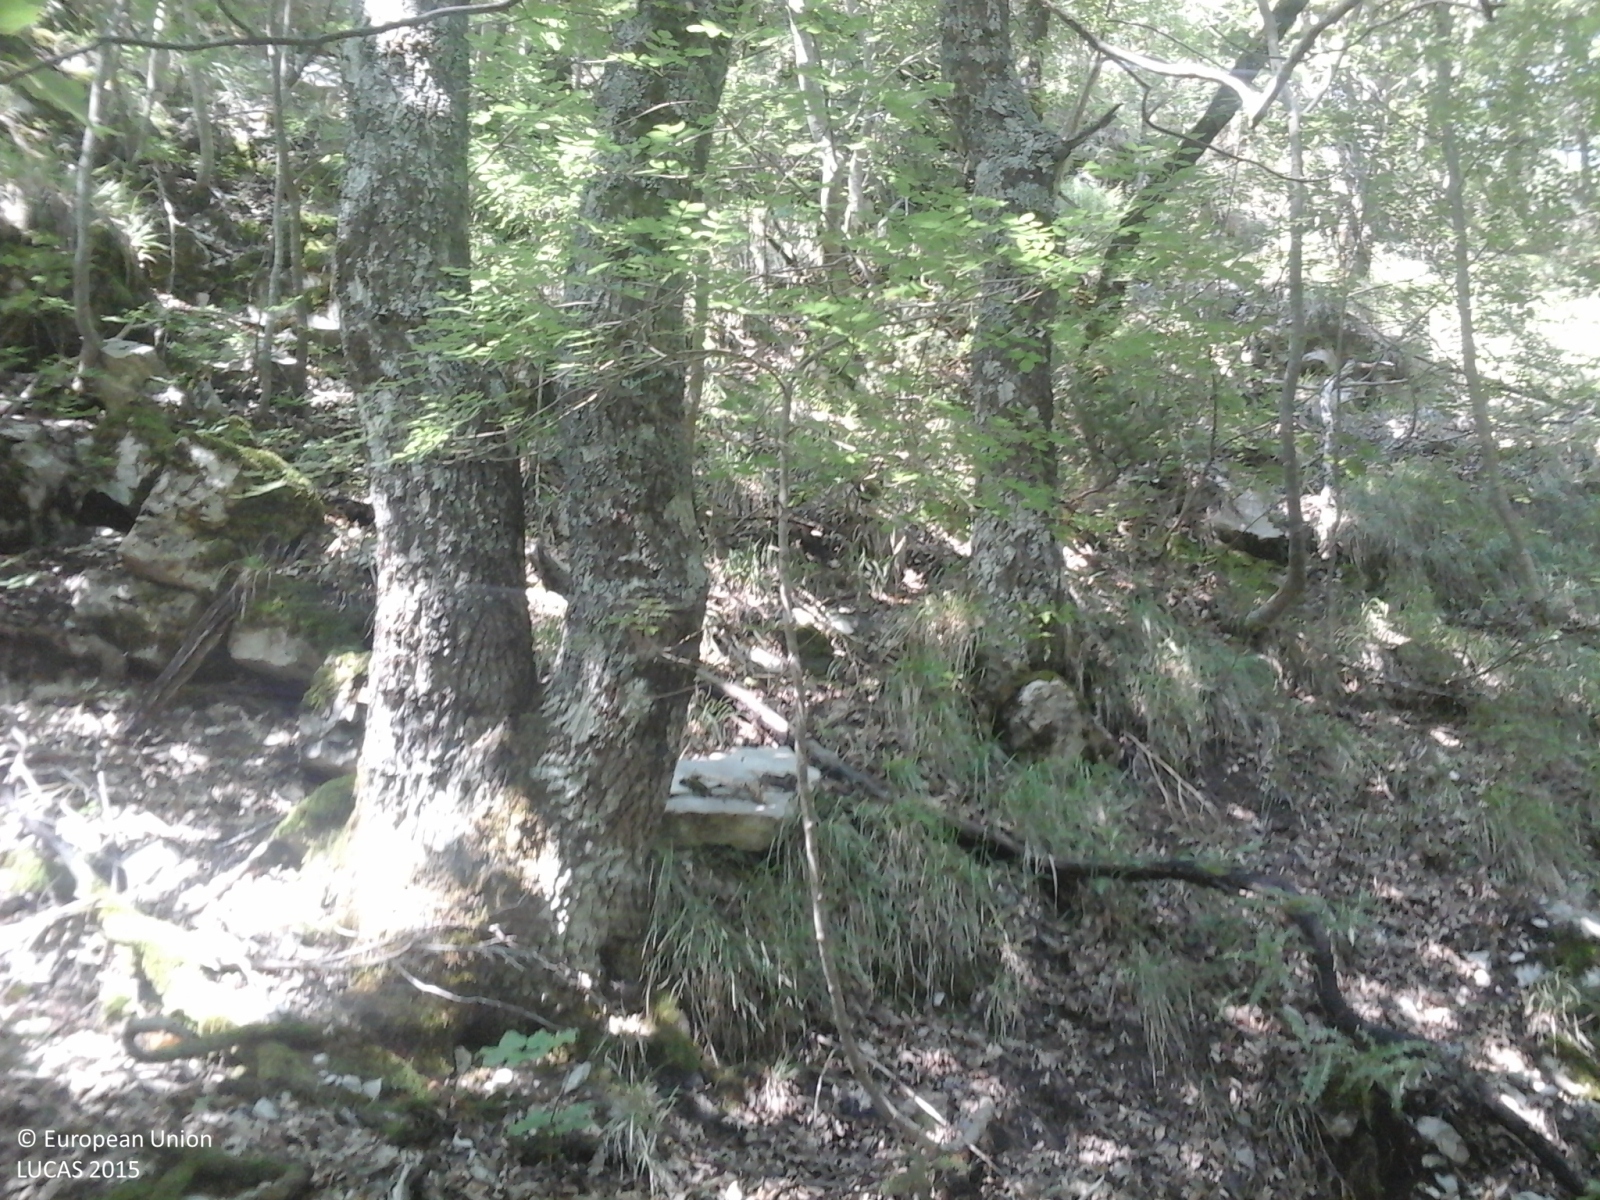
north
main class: Woodland
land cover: Broadleaved woodland
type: thermophilous deciduous forest
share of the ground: > 75 %
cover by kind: broadleaved forest trees 100 %
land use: Forestry
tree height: > 5 m
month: August
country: IT
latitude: 42.9472
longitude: 13.1898
